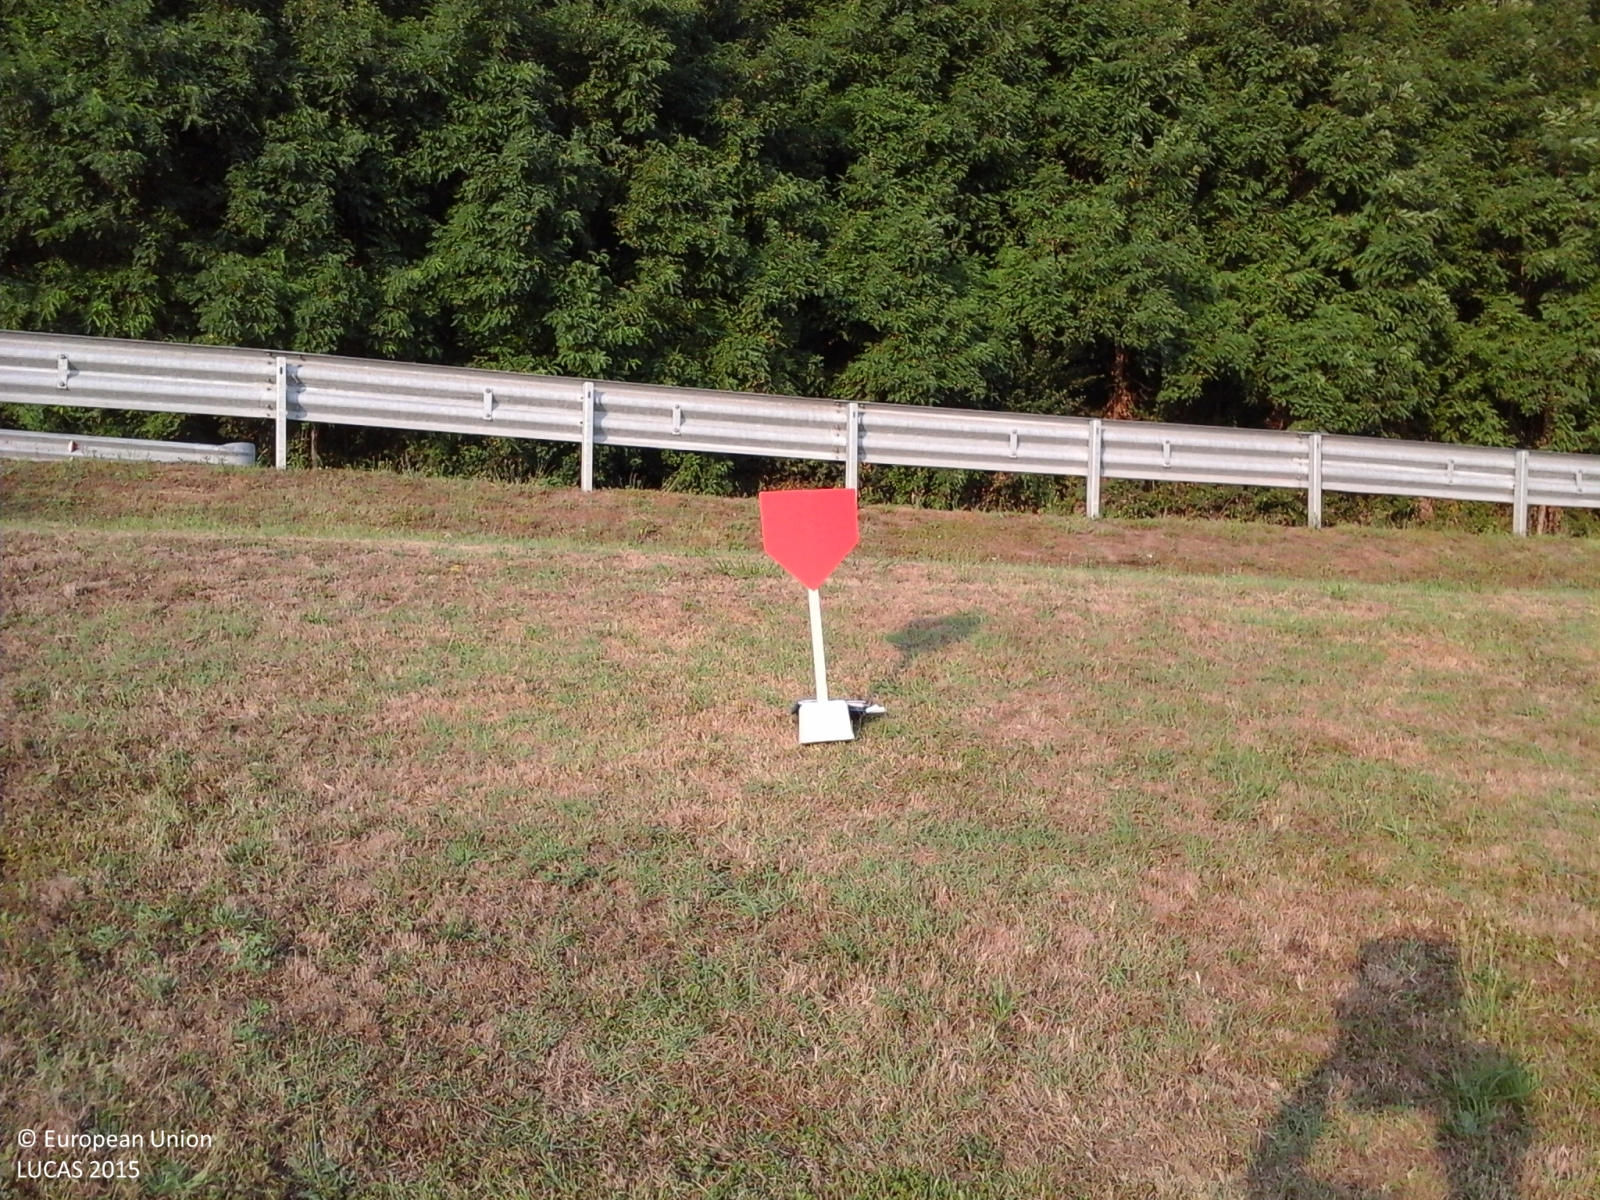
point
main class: Grassland
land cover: Grassland without tree/shrub cover
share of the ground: > 75 %
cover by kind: herbaceous plants 100 %
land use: Semi-natural and natural areas not in use
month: July
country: IT
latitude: 44.4085
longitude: 8.2834
